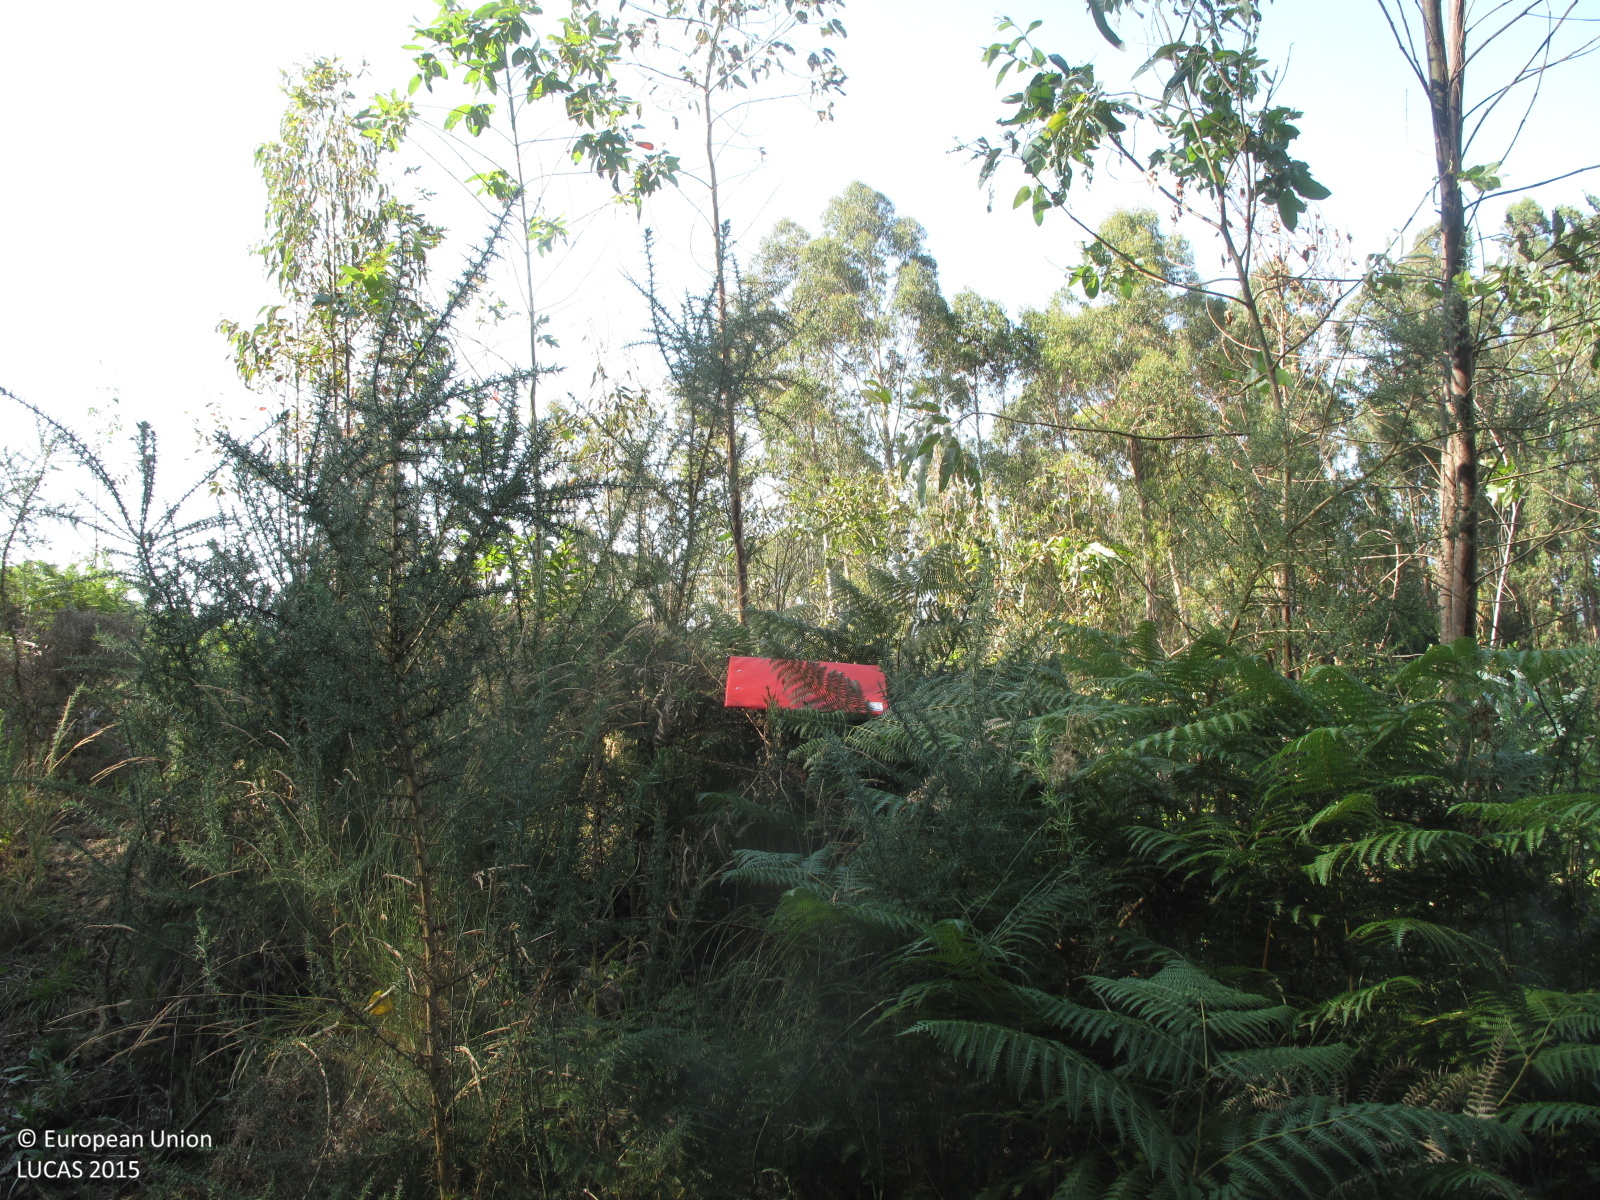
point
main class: Grassland
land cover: Grassland with sparse tree/shrub cover
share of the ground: 50 - 75 %
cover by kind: herbaceous plants 70 %, unconsolidated bare surface 20 %, broadleaved forest trees 5 %, shrubs 5 %
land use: Forestry
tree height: < 5 m
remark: Clear cut
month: July
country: ES
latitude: 43.3518
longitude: -8.0974
